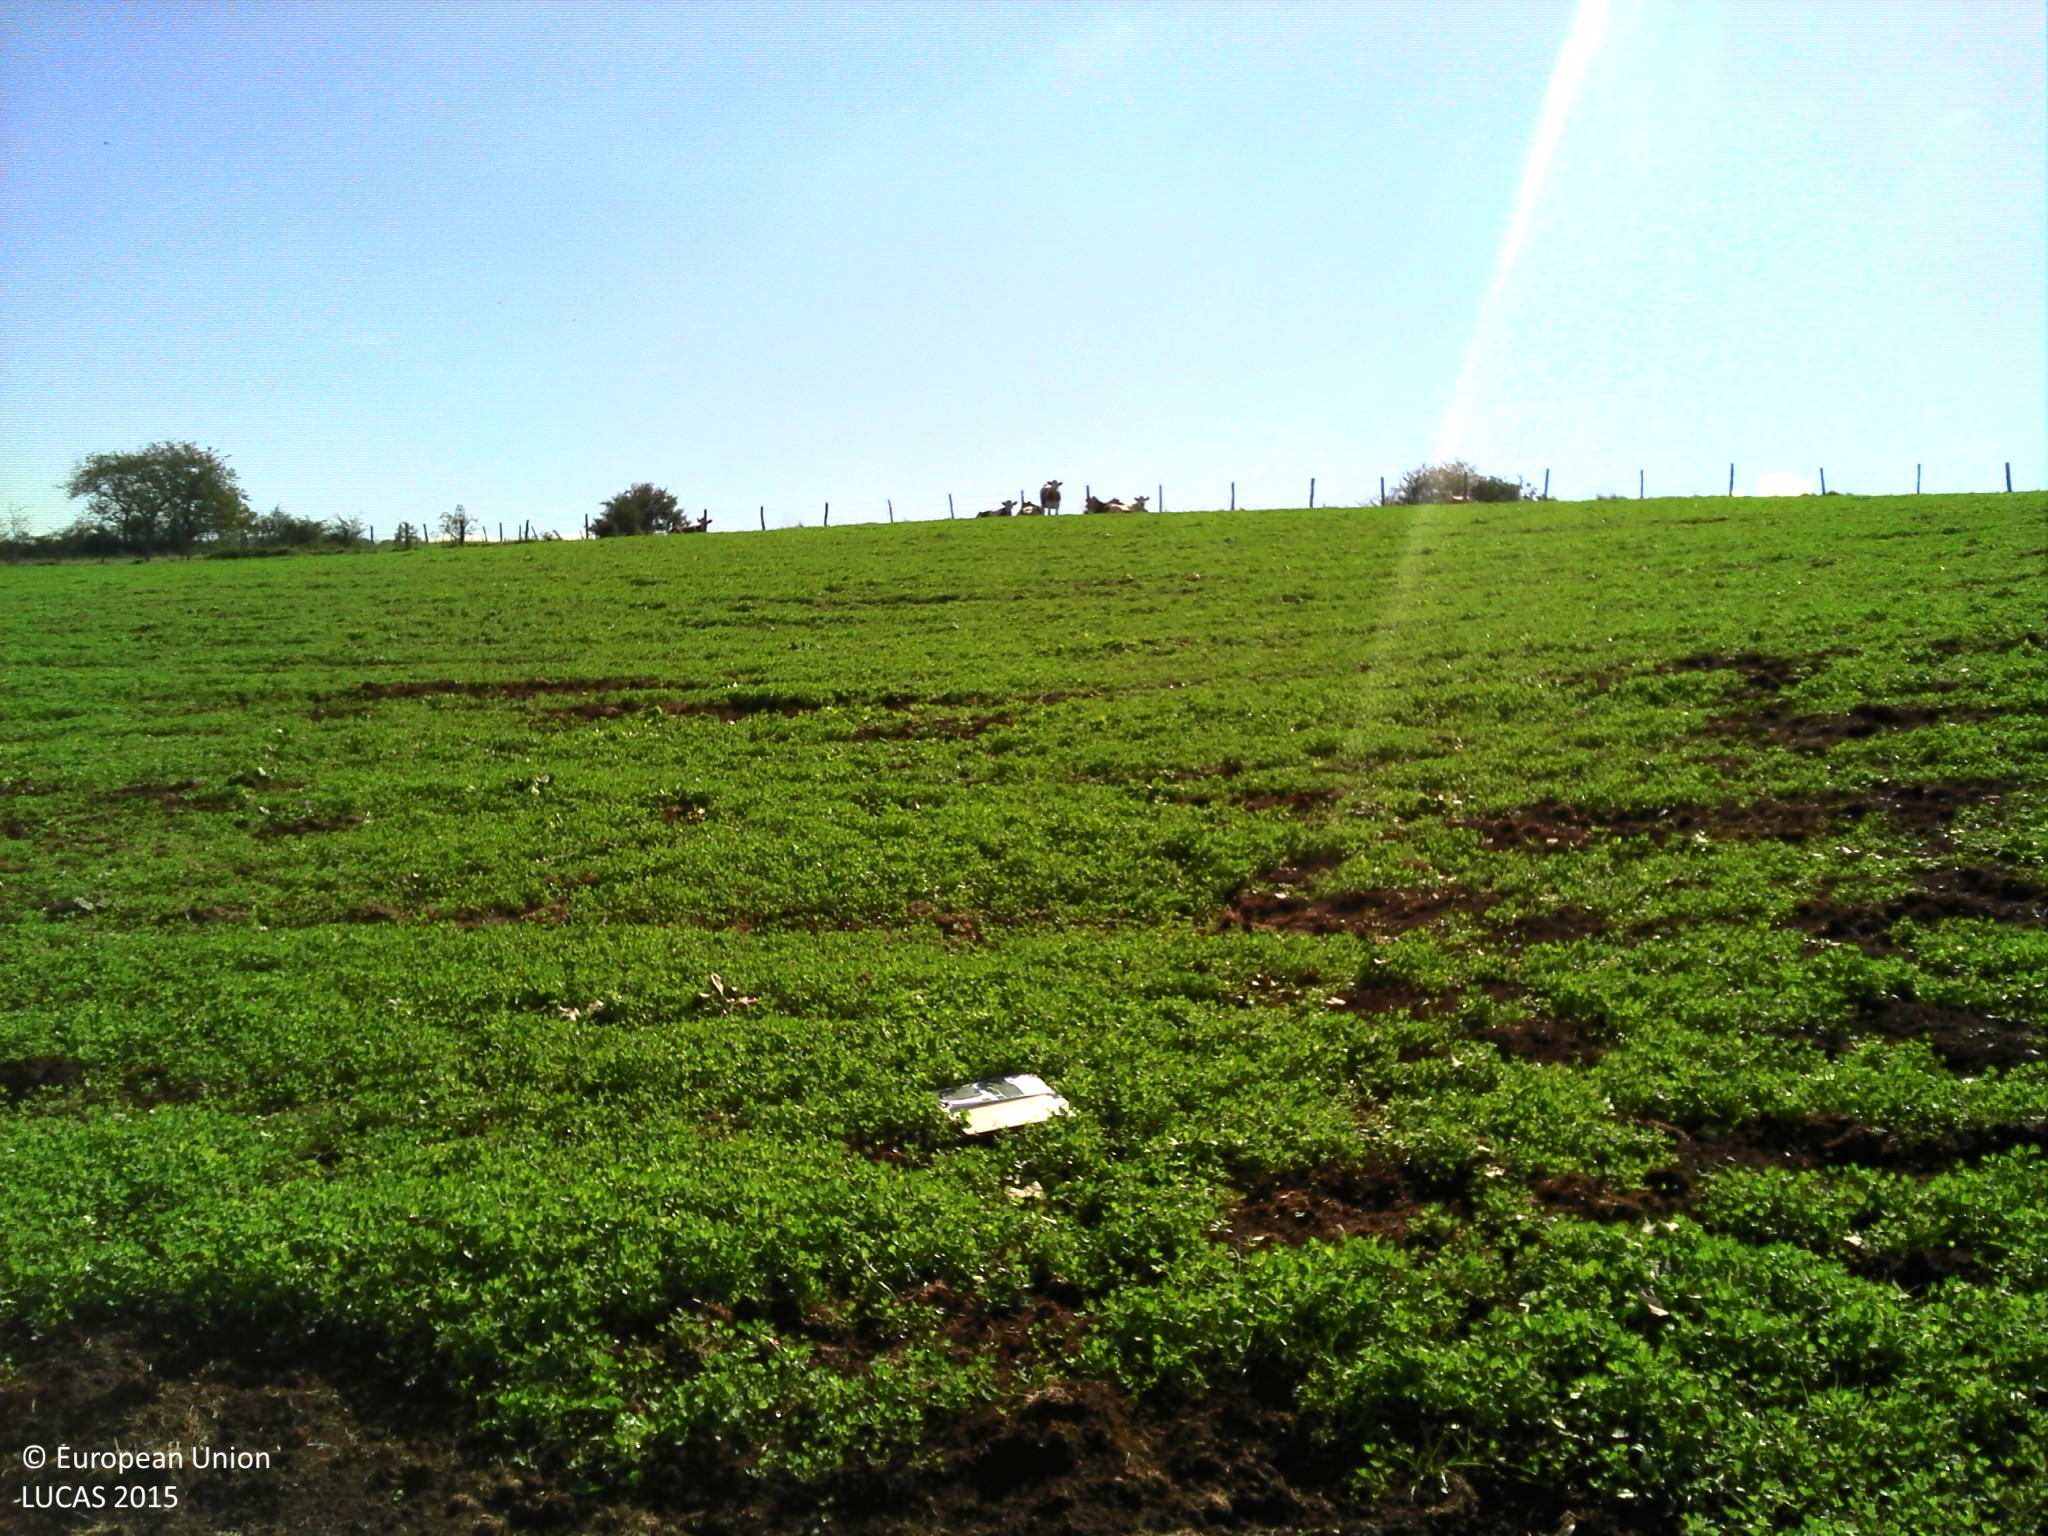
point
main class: Grassland
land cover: Spontaneously vegetated surfaces
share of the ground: > 75 %
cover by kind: herbaceous plants 95 %, shrubs 5 %
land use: Agriculture (excluding fallow land and kitchen gardens)
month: September
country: FR
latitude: 47.1146
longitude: 6.2460
